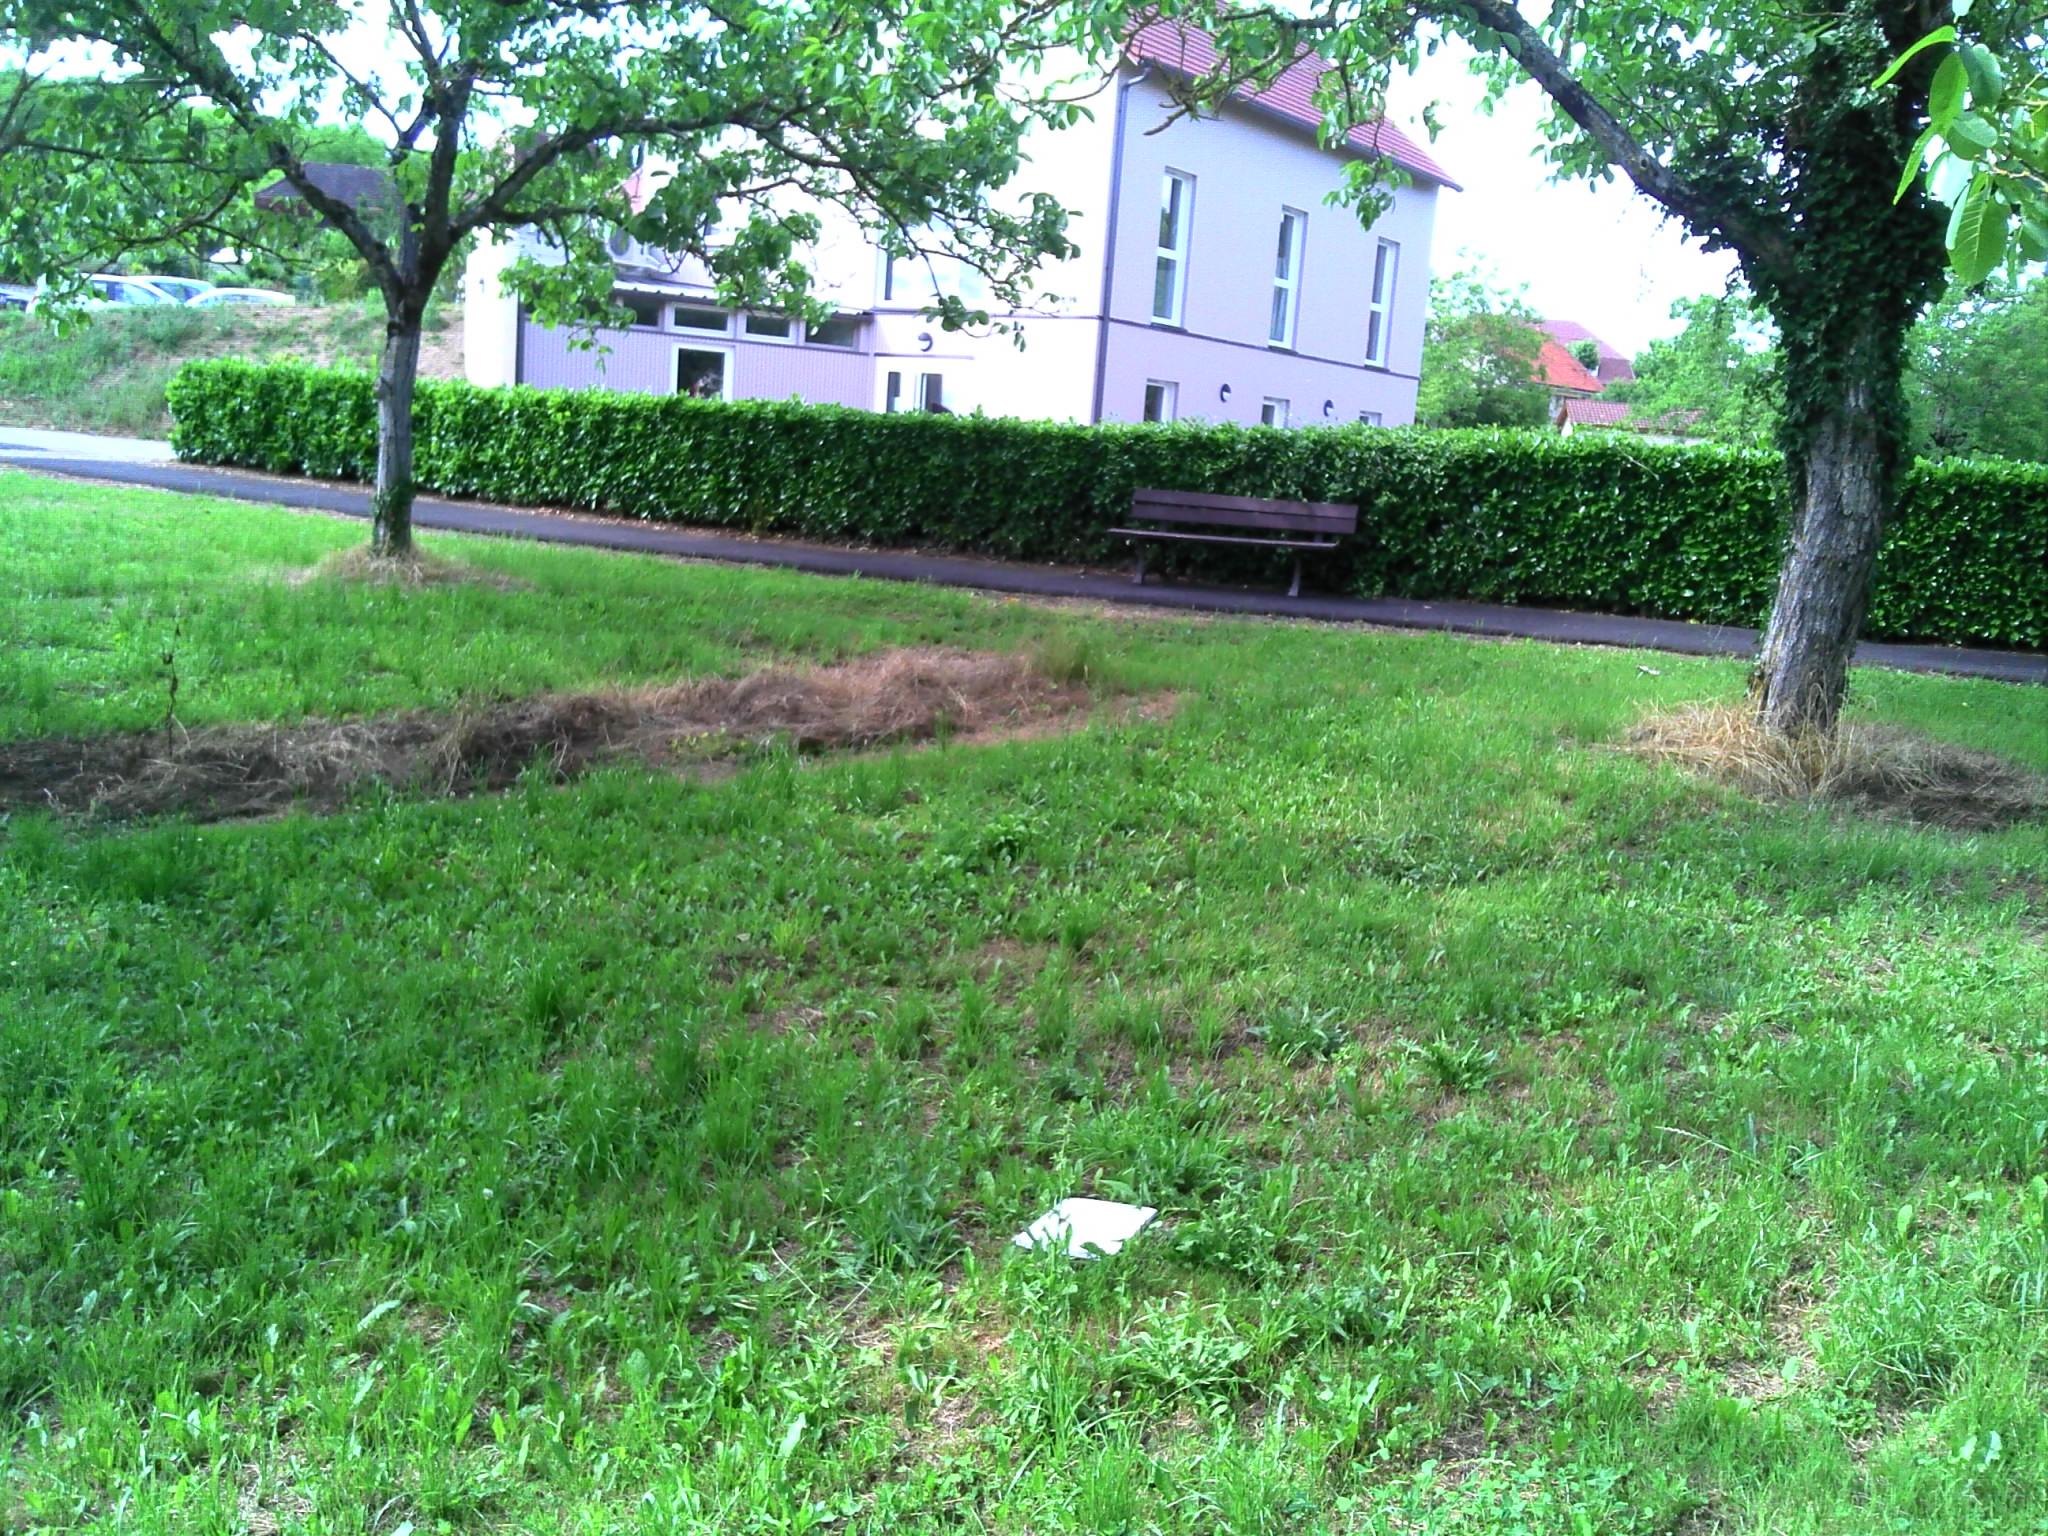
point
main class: Cropland
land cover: Nuts trees
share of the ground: > 75 %
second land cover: Grassland without tree/shrub cover
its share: 10 - 25 %
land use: Agriculture (excluding fallow land and kitchen gardens)
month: June
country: FR
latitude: 44.9195
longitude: 1.8778
